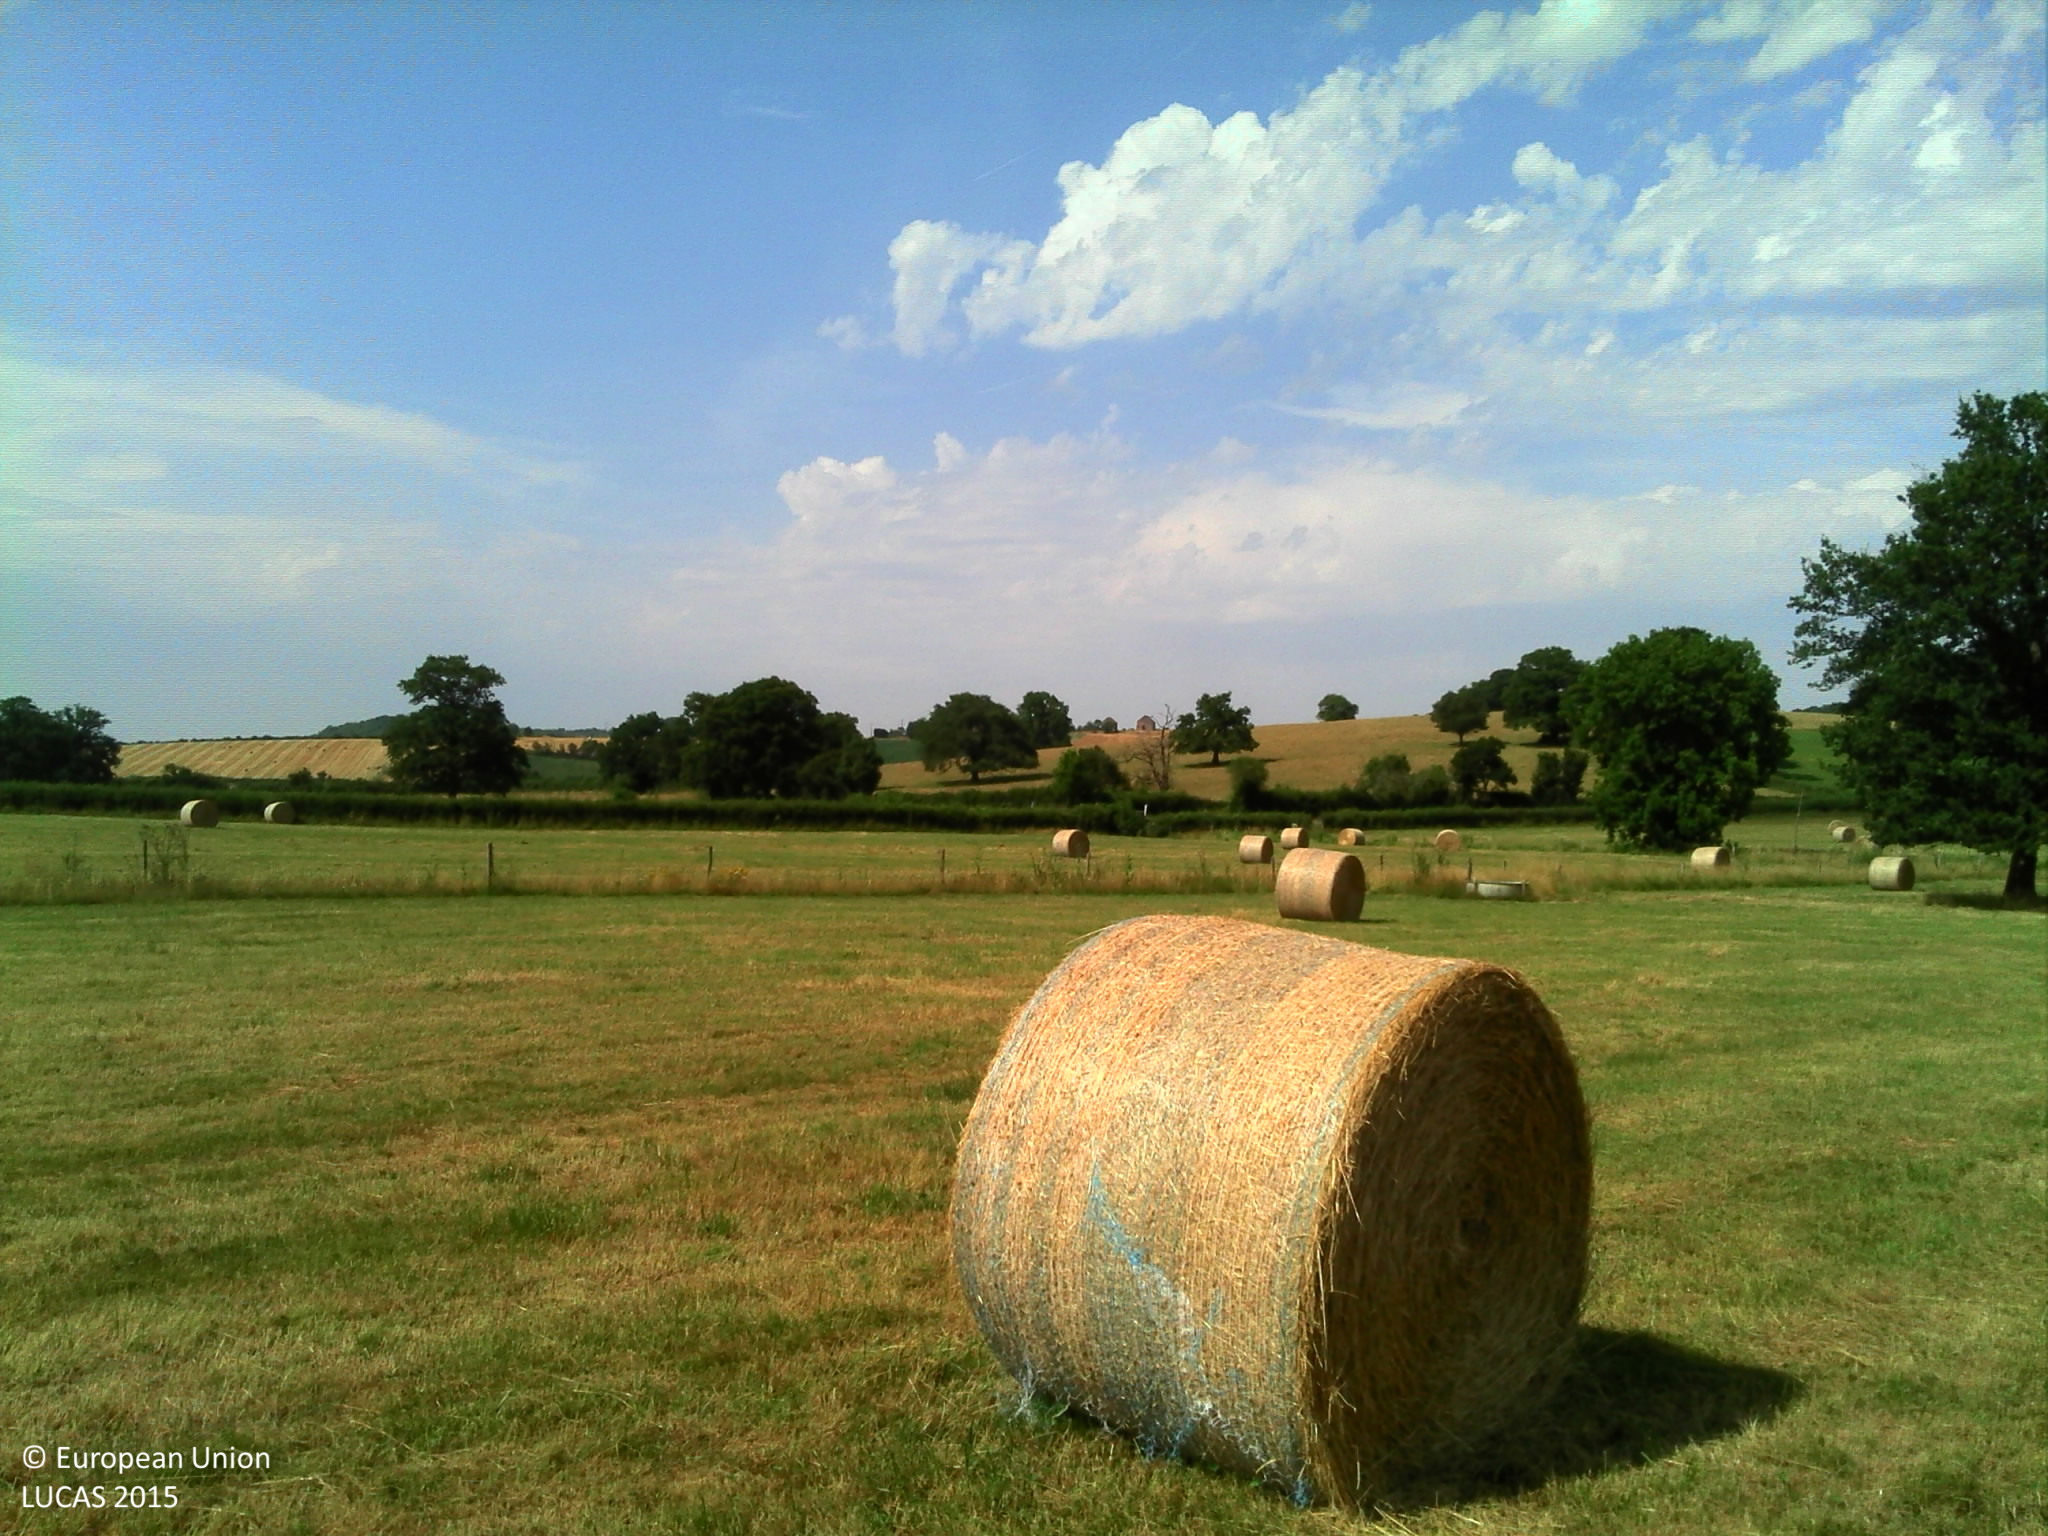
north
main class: Grassland
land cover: Grassland without tree/shrub cover
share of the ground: > 75 %
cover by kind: herbaceous plants 100 %
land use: Agriculture (excluding fallow land and kitchen gardens)
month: July
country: FR
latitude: 47.2379
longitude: 3.5109
